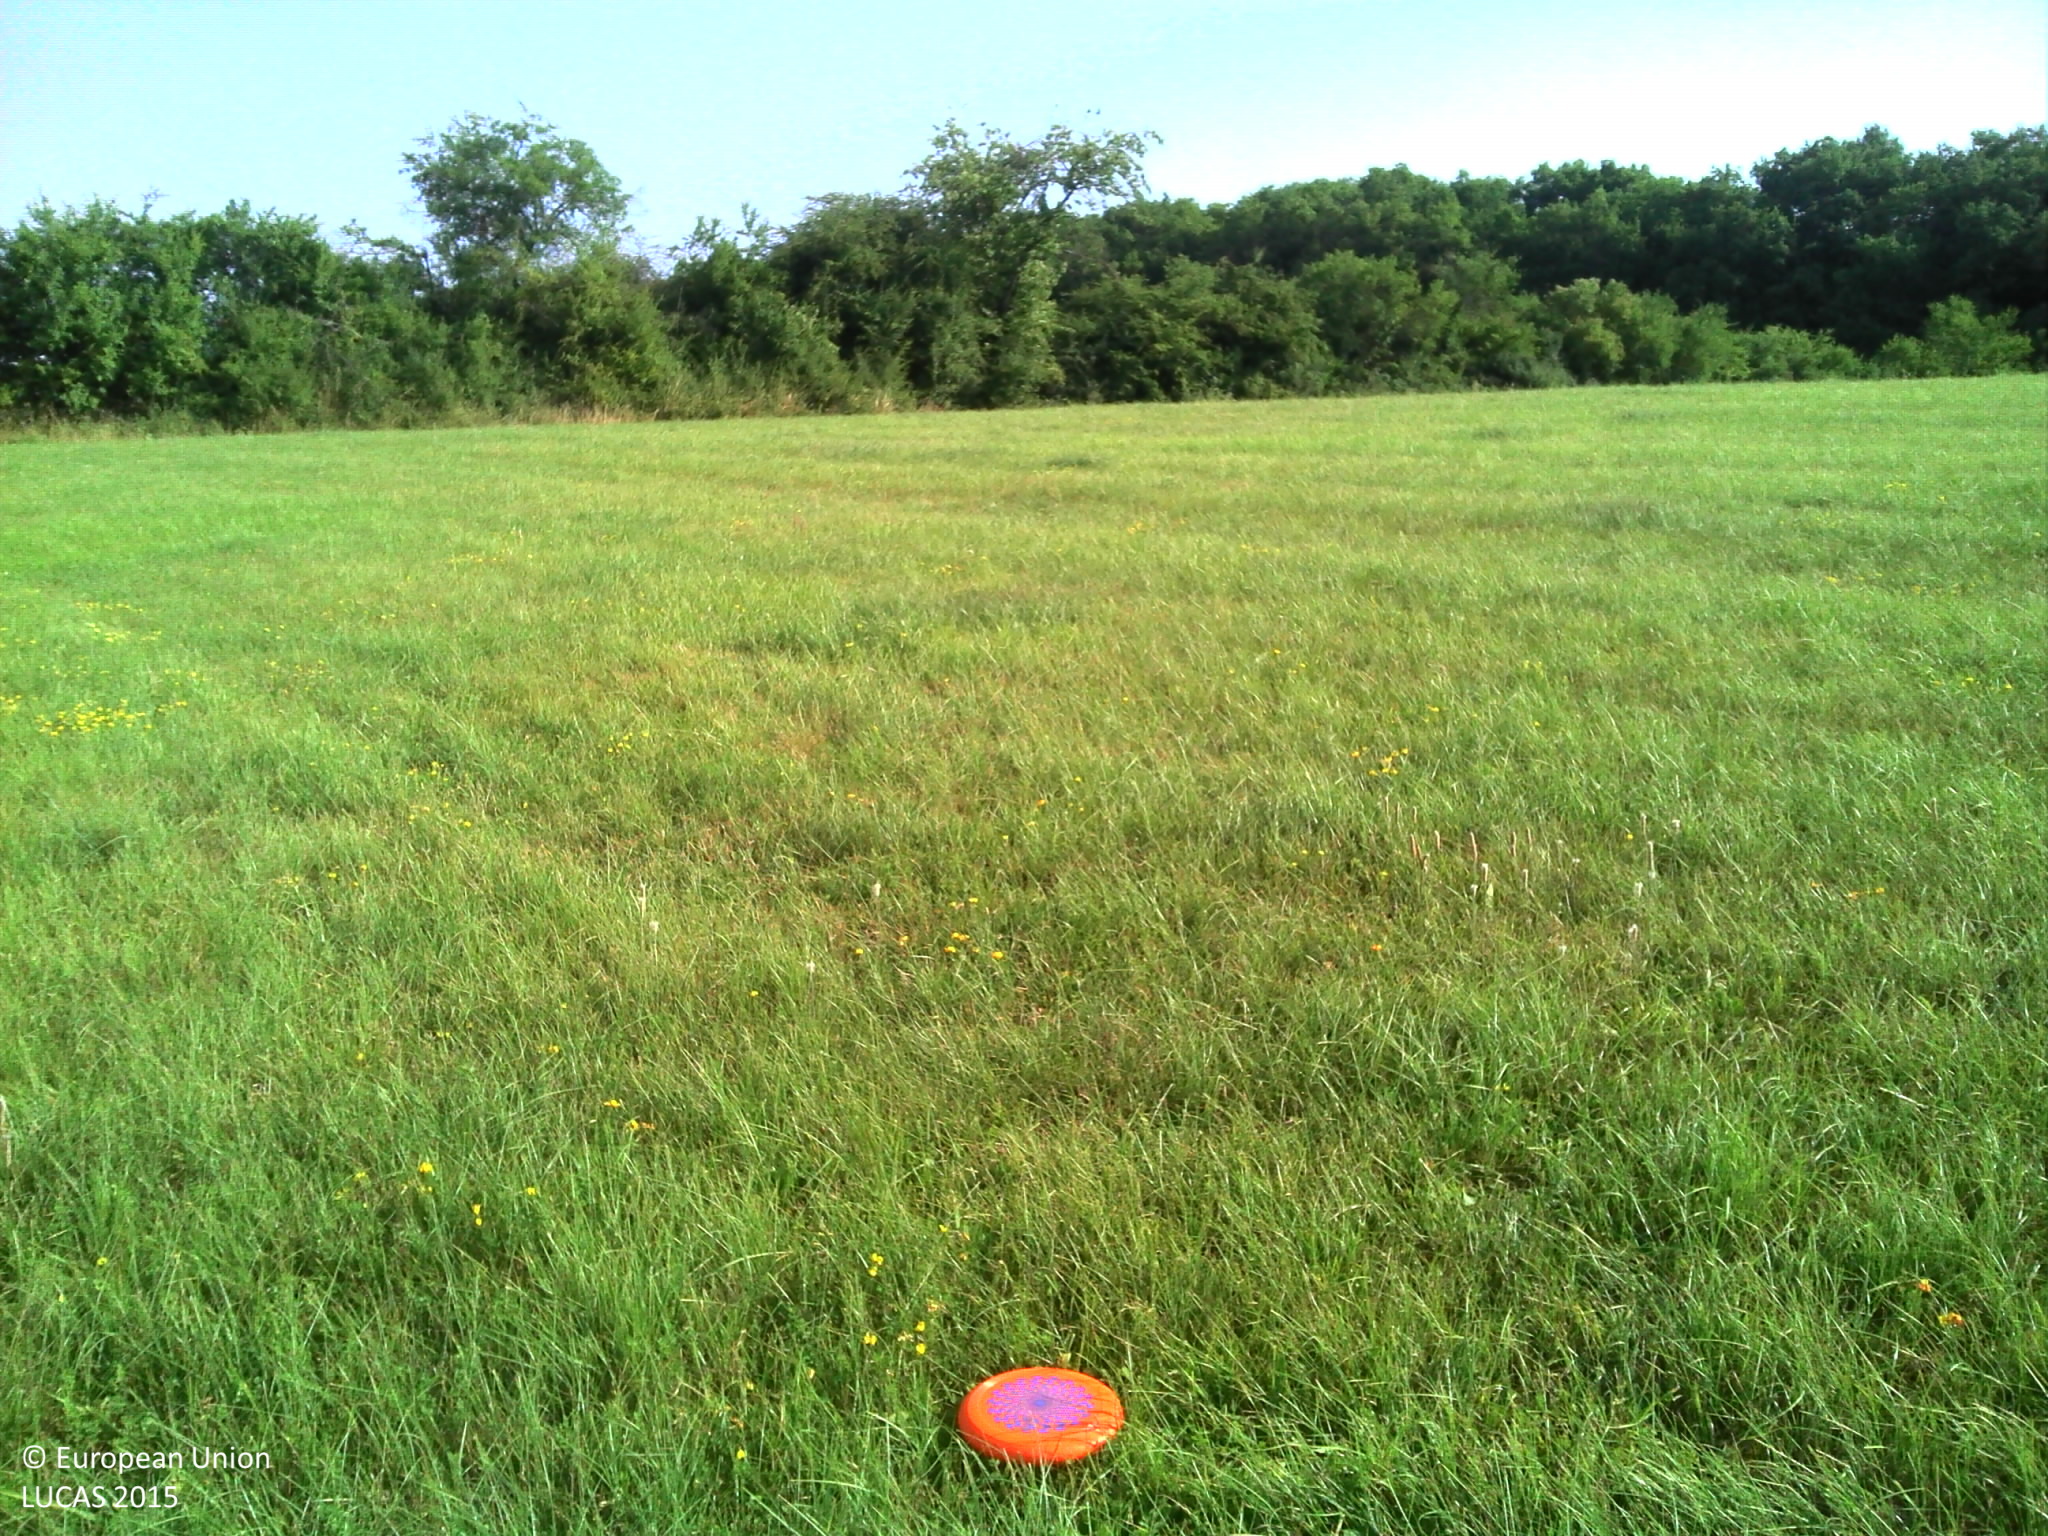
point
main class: Cropland
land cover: Temporary grasslands
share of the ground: > 75 %
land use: Agriculture (excluding fallow land and kitchen gardens)
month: July
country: FR
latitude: 45.7624
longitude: 5.3367
